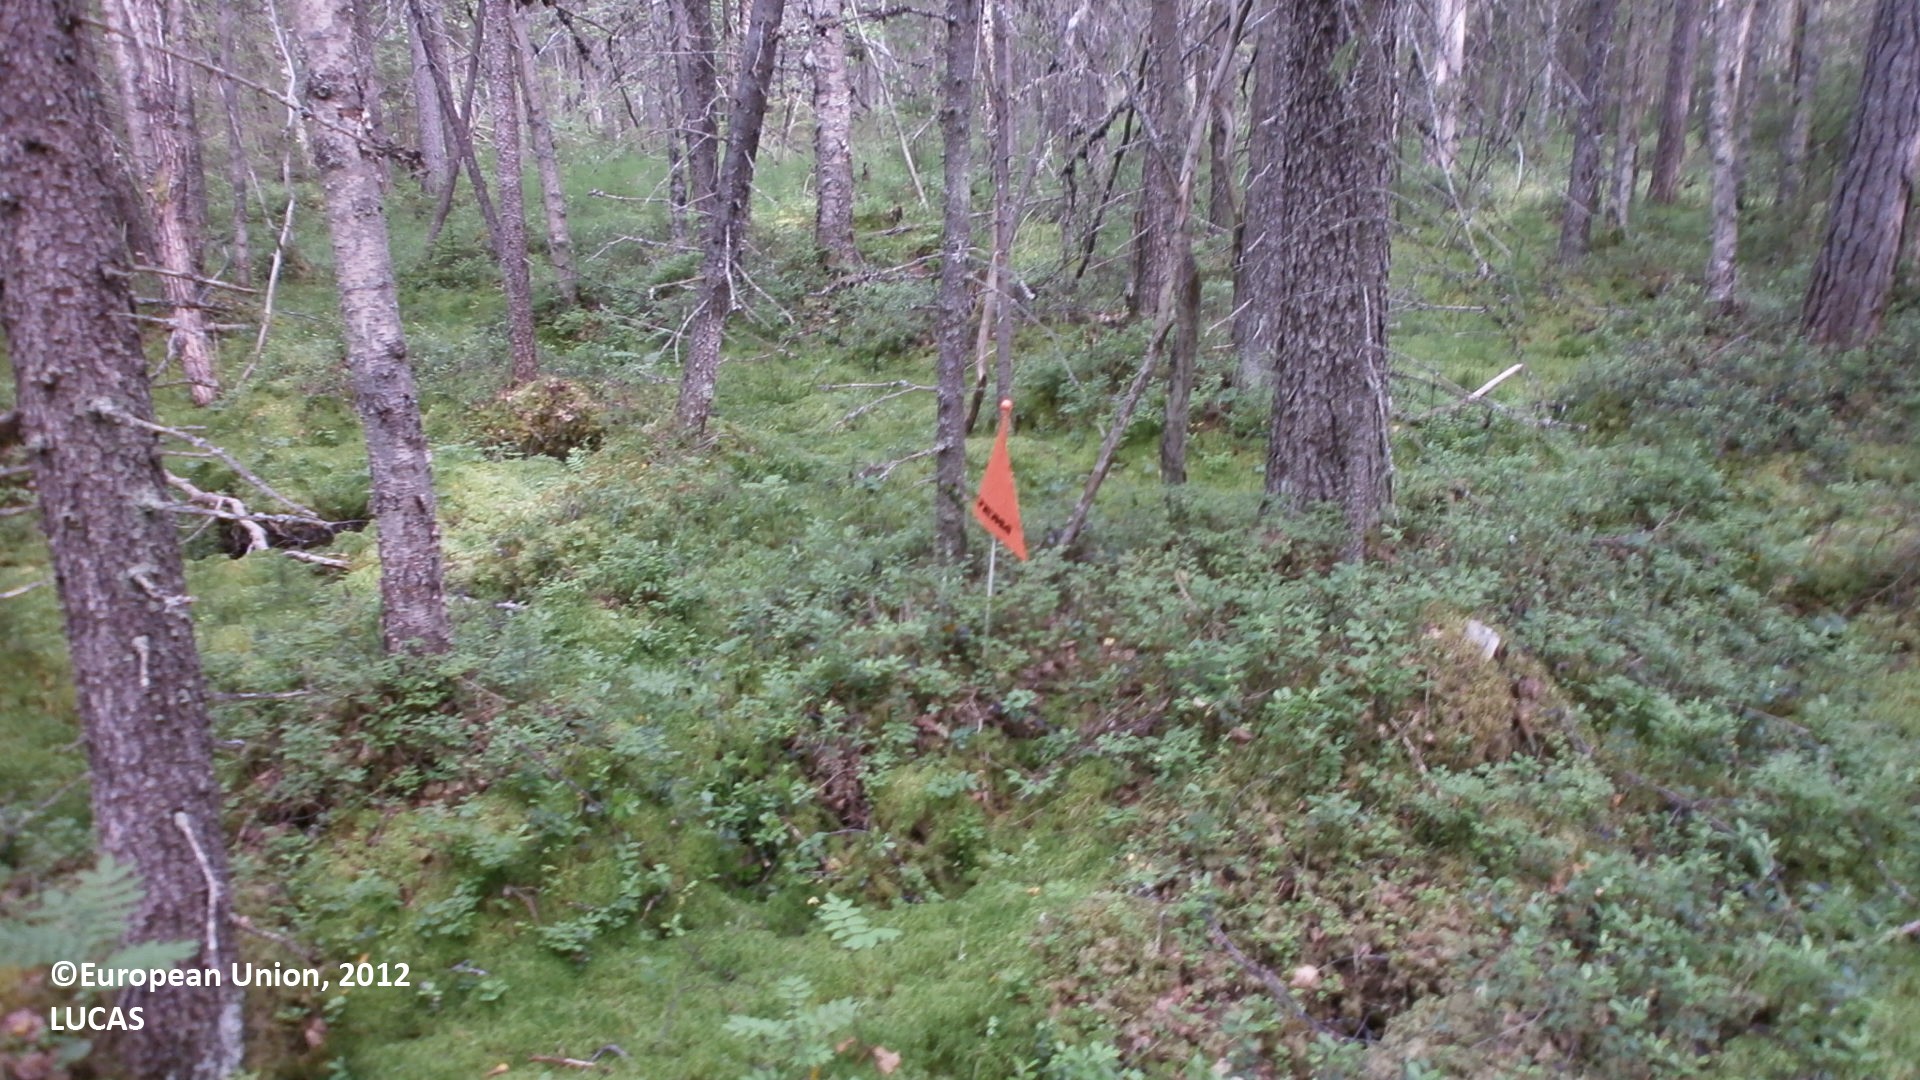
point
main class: Woodland
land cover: Spruce dominated mixed woodland
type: boreal forest
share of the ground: > 75 %
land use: Forestry
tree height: > 5 m
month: July
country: FI
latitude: 64.0768
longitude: 23.9018
